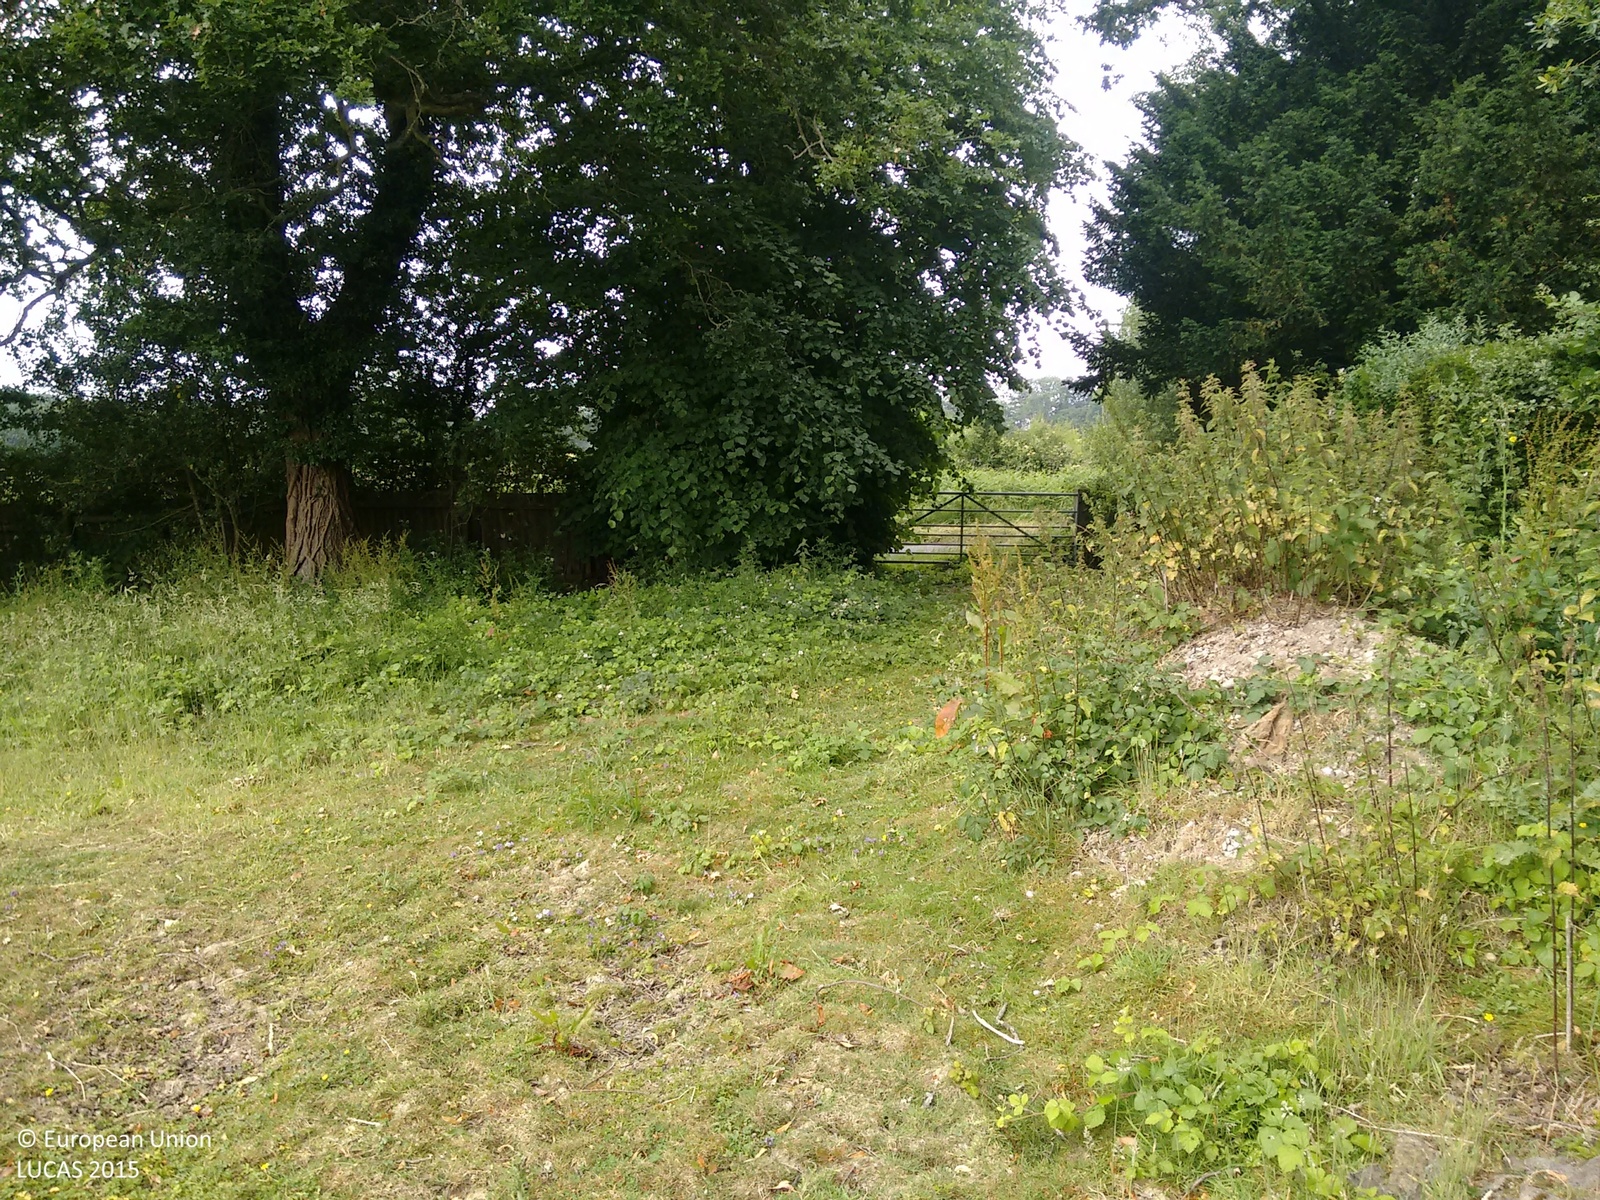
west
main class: Grassland
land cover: Grassland without tree/shrub cover
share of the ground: > 75 %
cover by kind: herbaceous plants 100 %
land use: Agriculture (excluding fallow land and kitchen gardens)
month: July
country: GB
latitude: 51.0331
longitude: -0.1734
